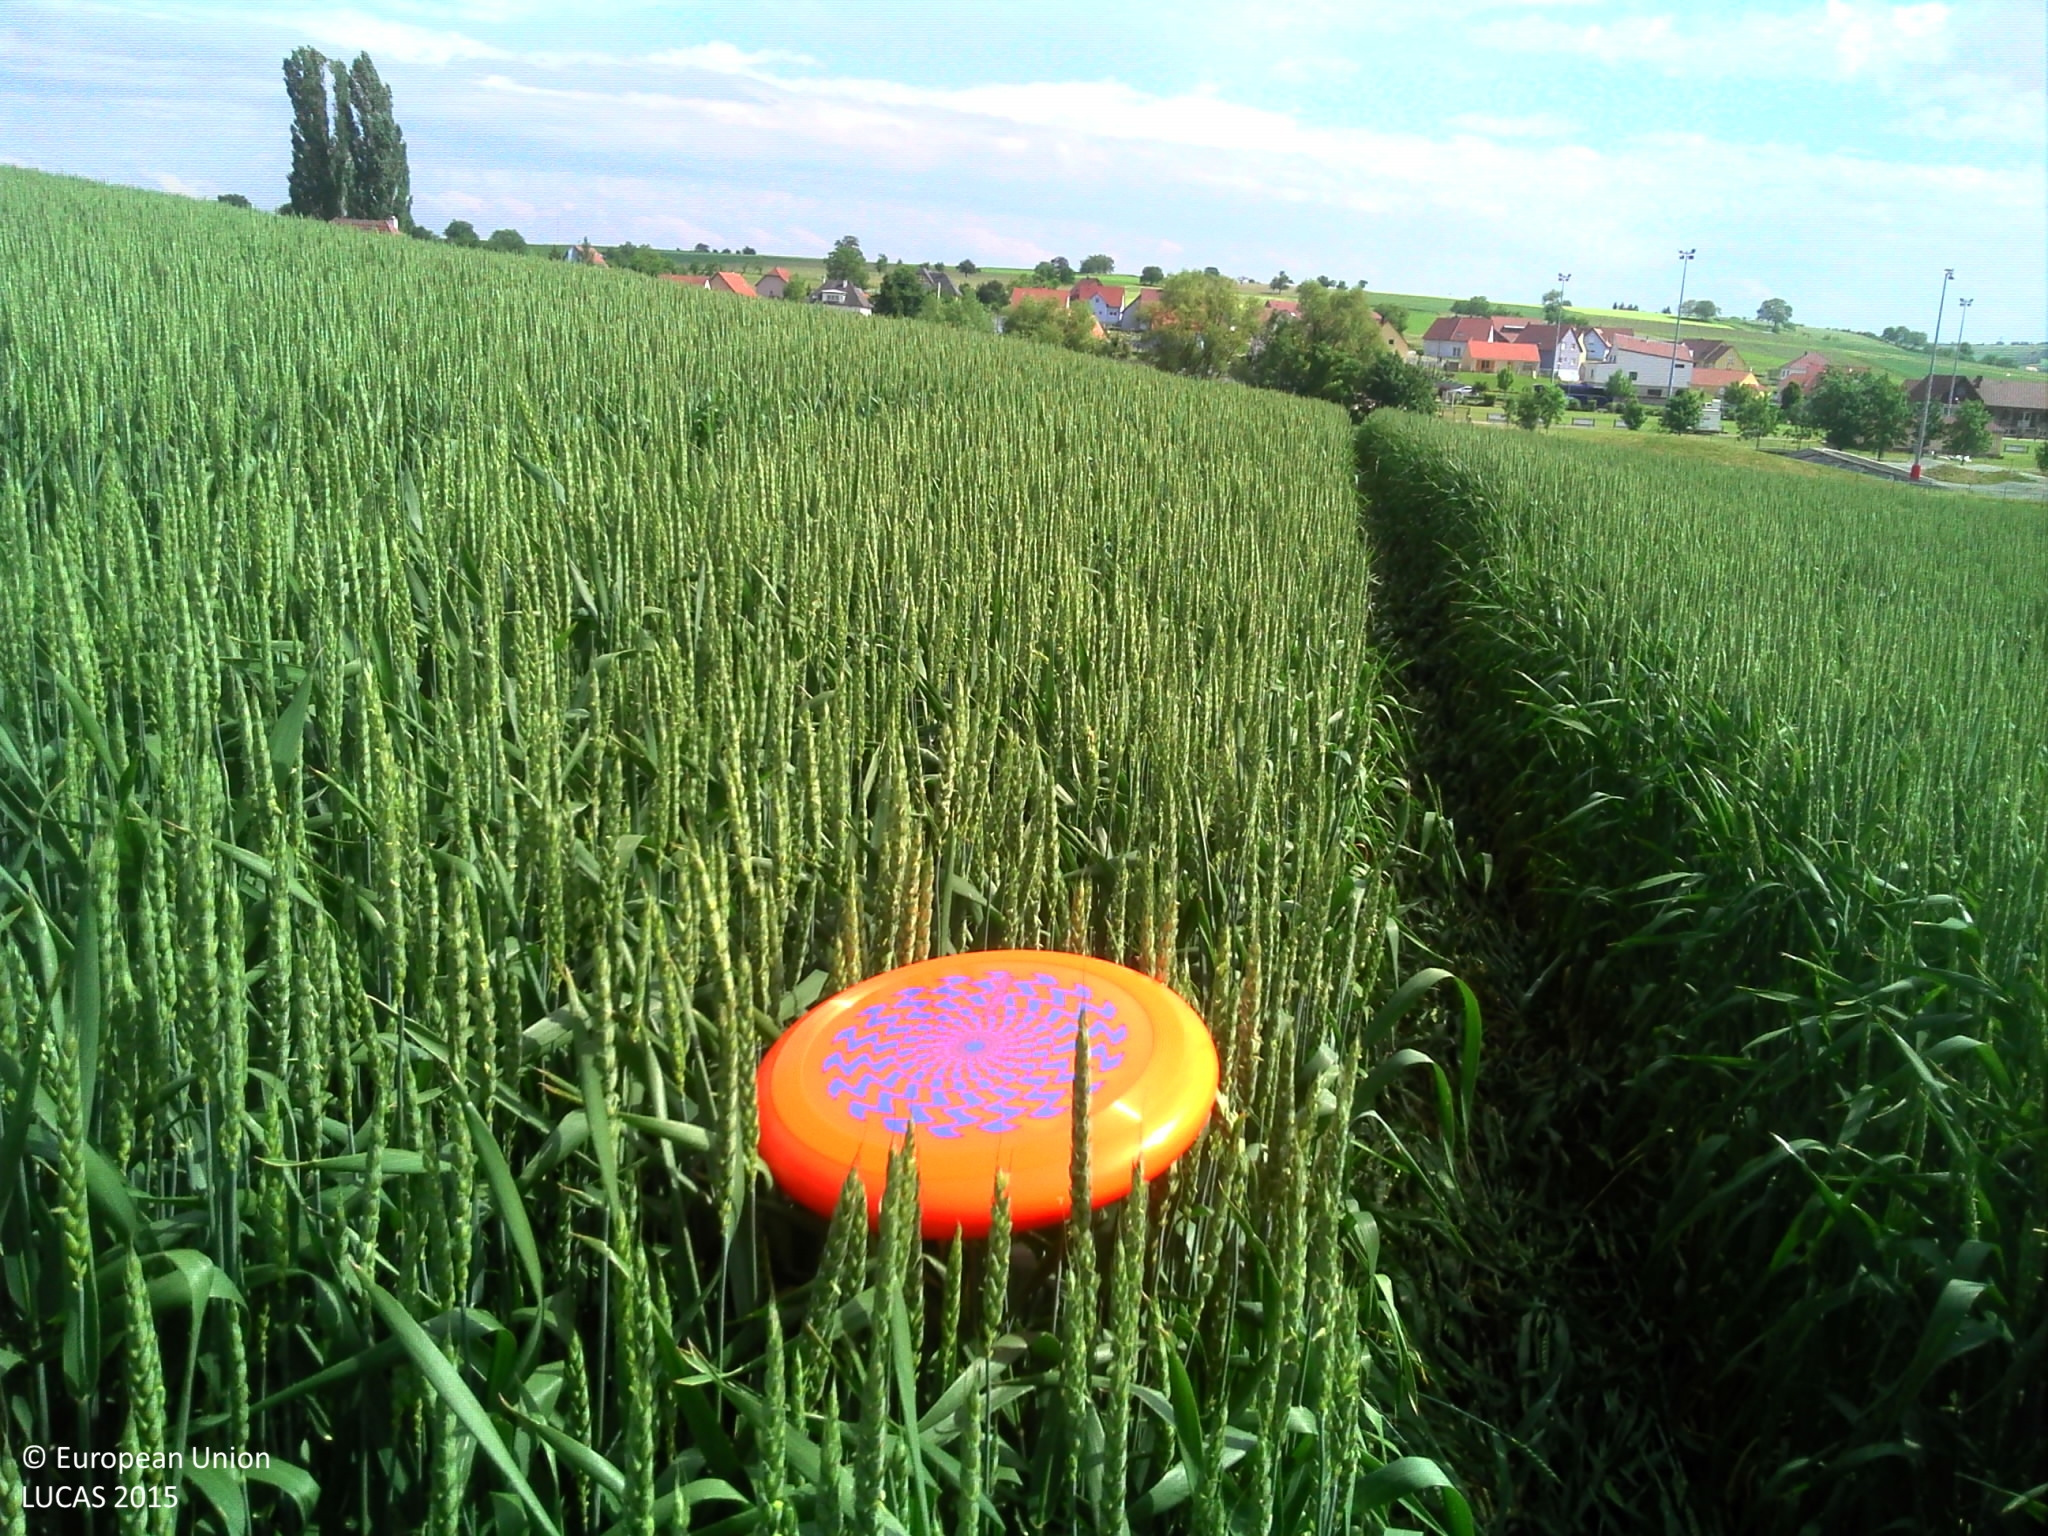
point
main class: Cropland
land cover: Common wheat
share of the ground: > 75 %
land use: Agriculture (excluding fallow land and kitchen gardens)
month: May
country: FR
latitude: 48.7151
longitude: 7.4048
